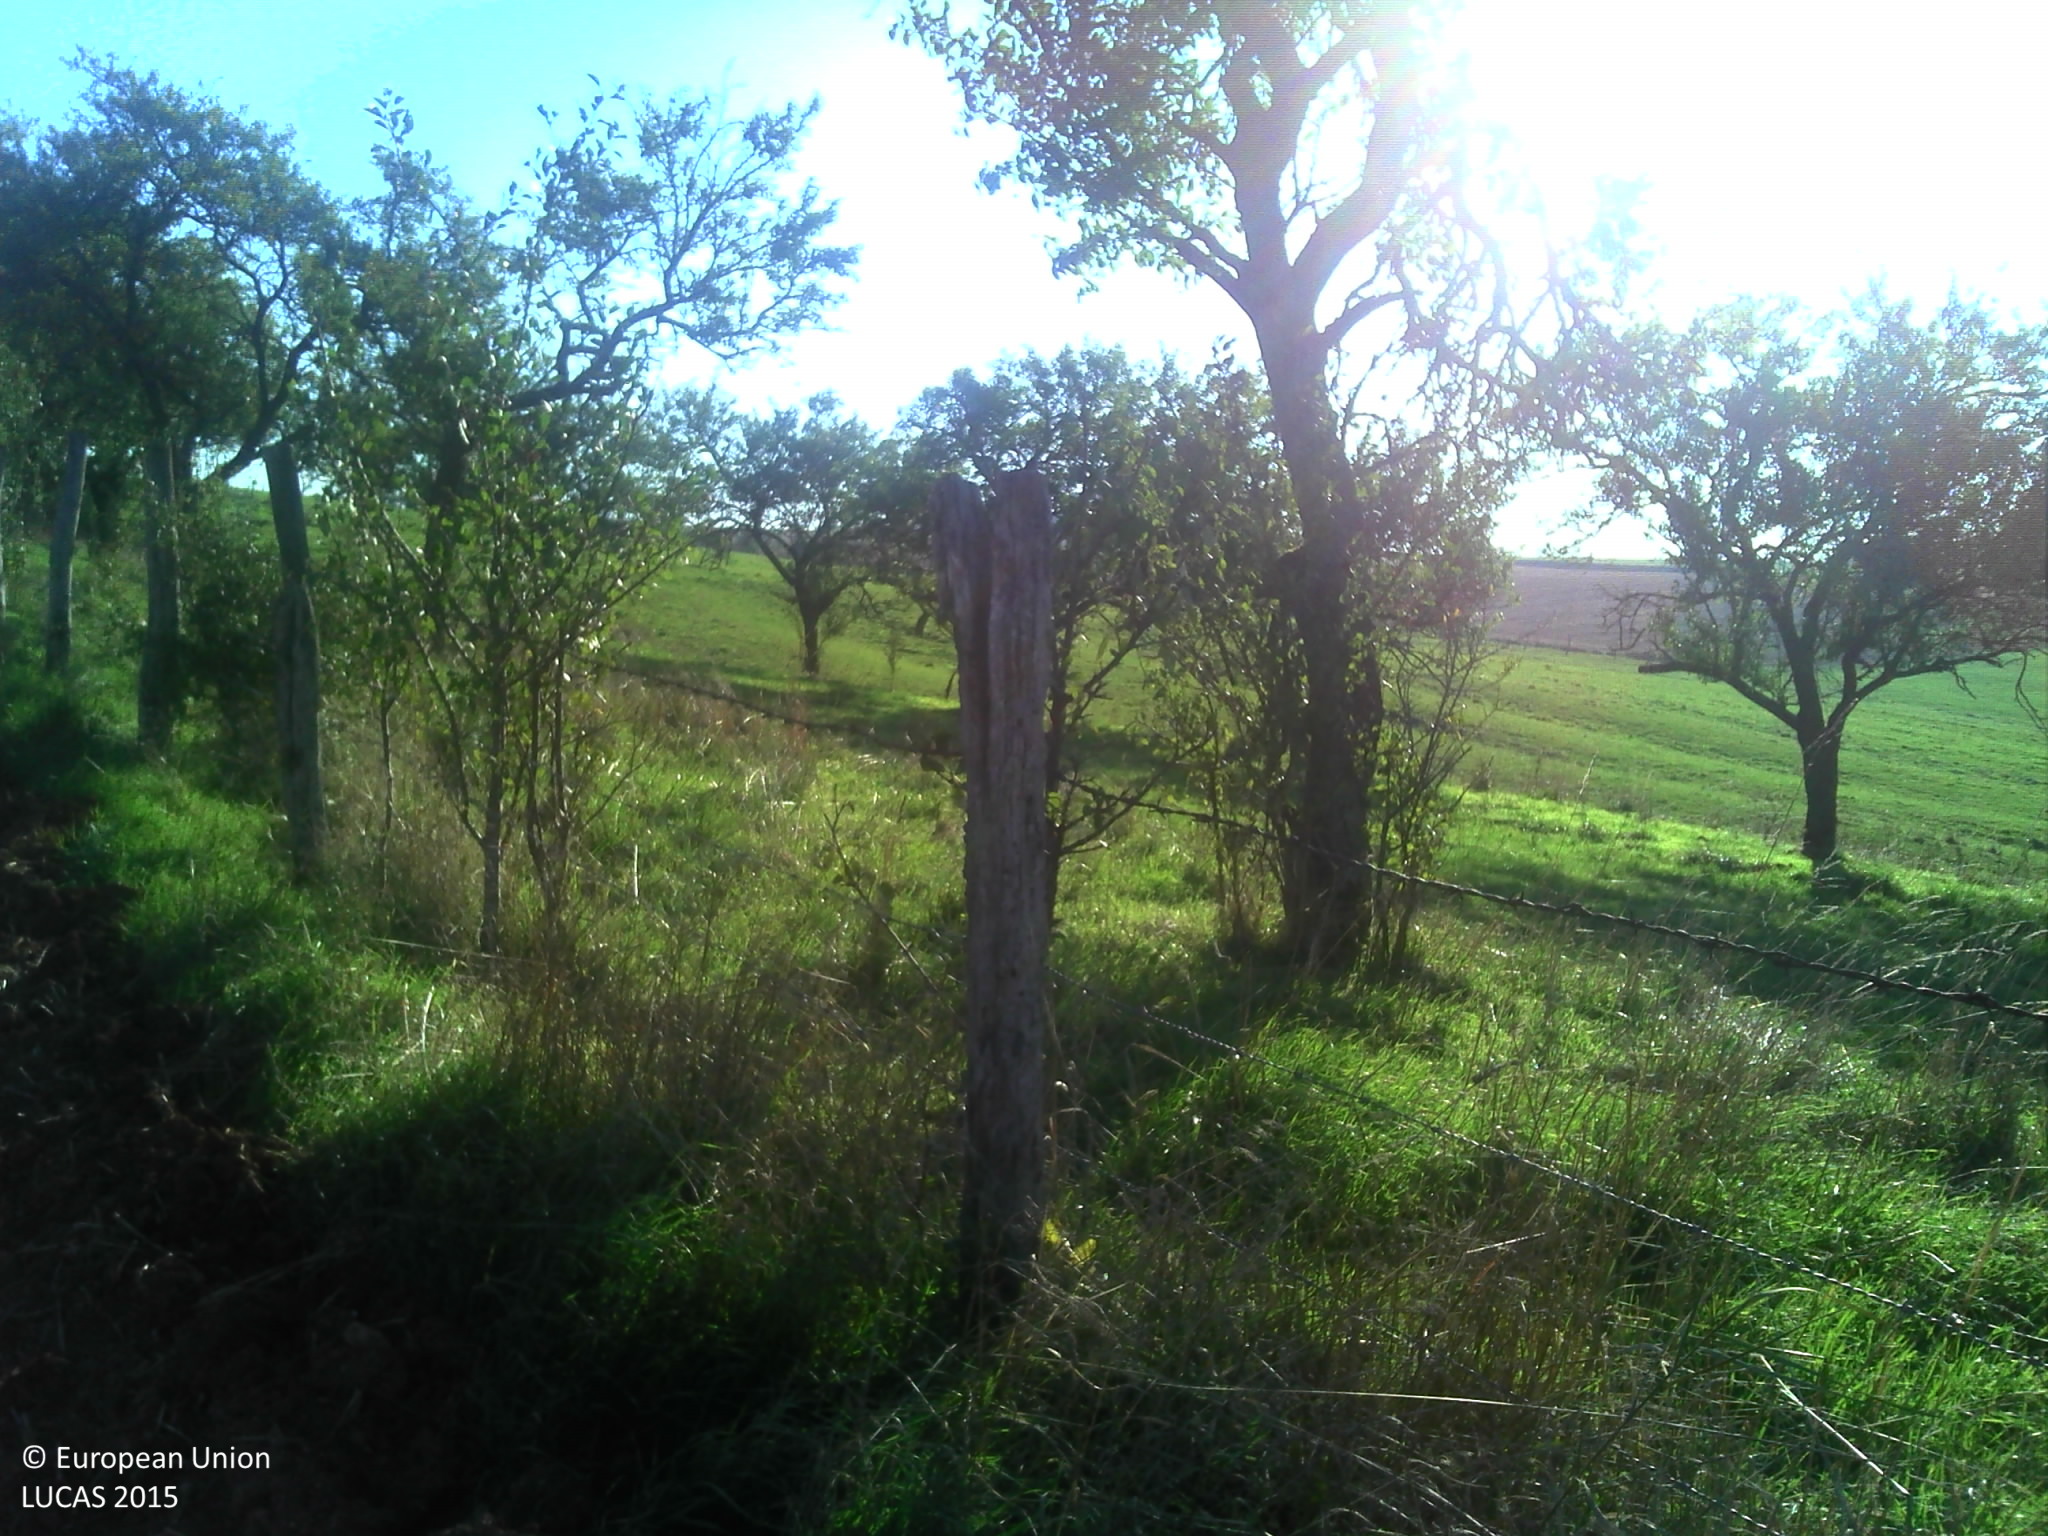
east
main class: Cropland
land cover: Common wheat
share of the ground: < 10 %
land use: Agriculture (excluding fallow land and kitchen gardens)
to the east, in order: Other fruit trees and berries; Grassland without tree/shrub cover; Other fruit trees and berries; Grassland without tree/shrub cover; Fences; Abandoned hedges; Grass margins; Common wheat
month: October
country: FR
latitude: 48.5389
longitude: 6.2756
